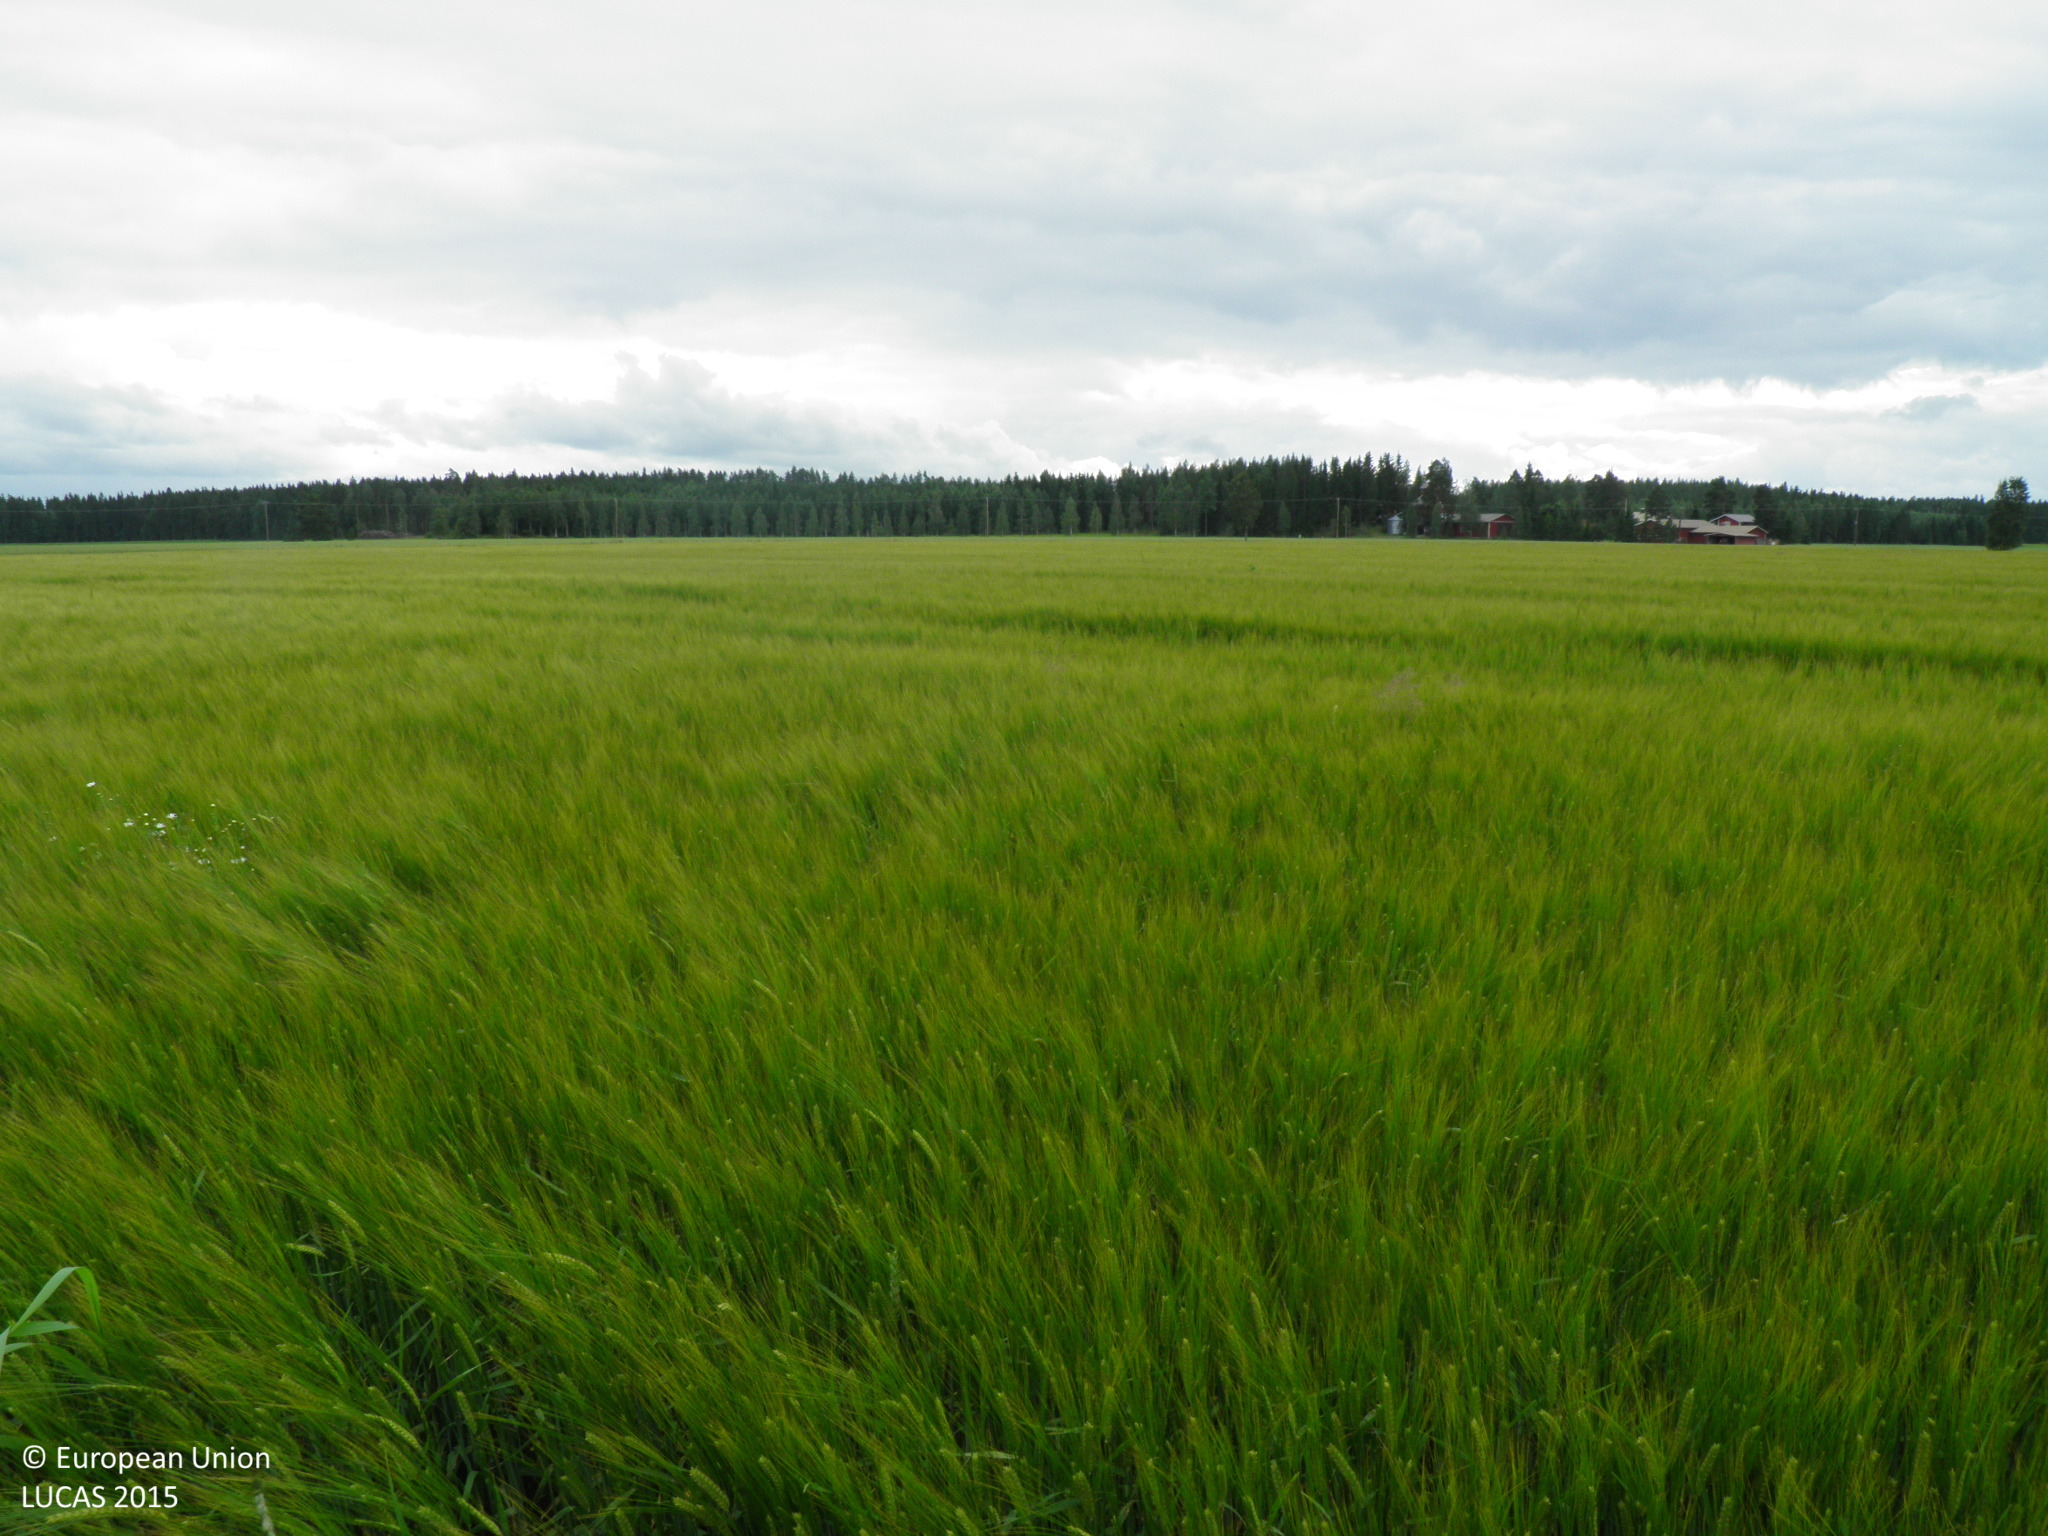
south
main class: Cropland
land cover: Barley
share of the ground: > 75 %
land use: Agriculture (excluding fallow land and kitchen gardens)
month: July
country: FI
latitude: 60.8864
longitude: 23.0662
